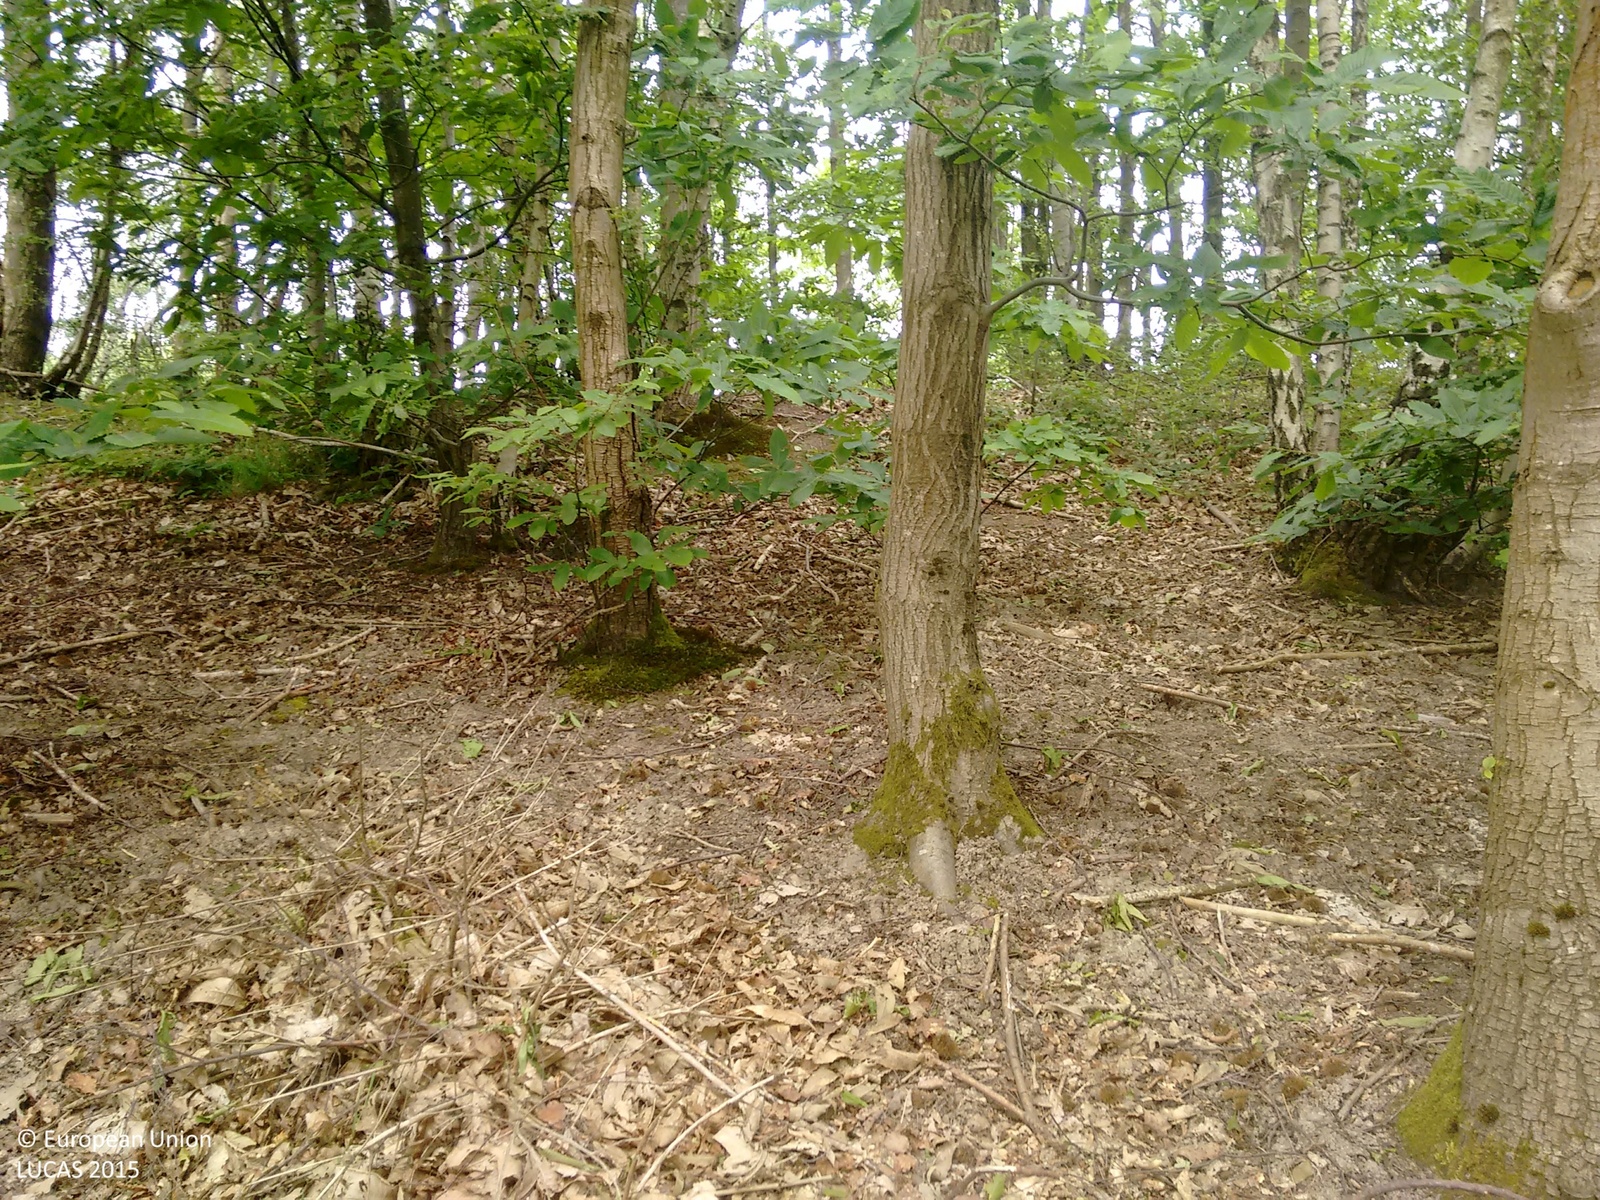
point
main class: Woodland
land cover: Broadleaved woodland
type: mesophytic deciduous forest
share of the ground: > 75 %
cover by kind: broadleaved forest trees 90 %, shrubs 10 %
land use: Waste treatment
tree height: > 5 m
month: June
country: GB
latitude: 51.0816
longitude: 0.3927
